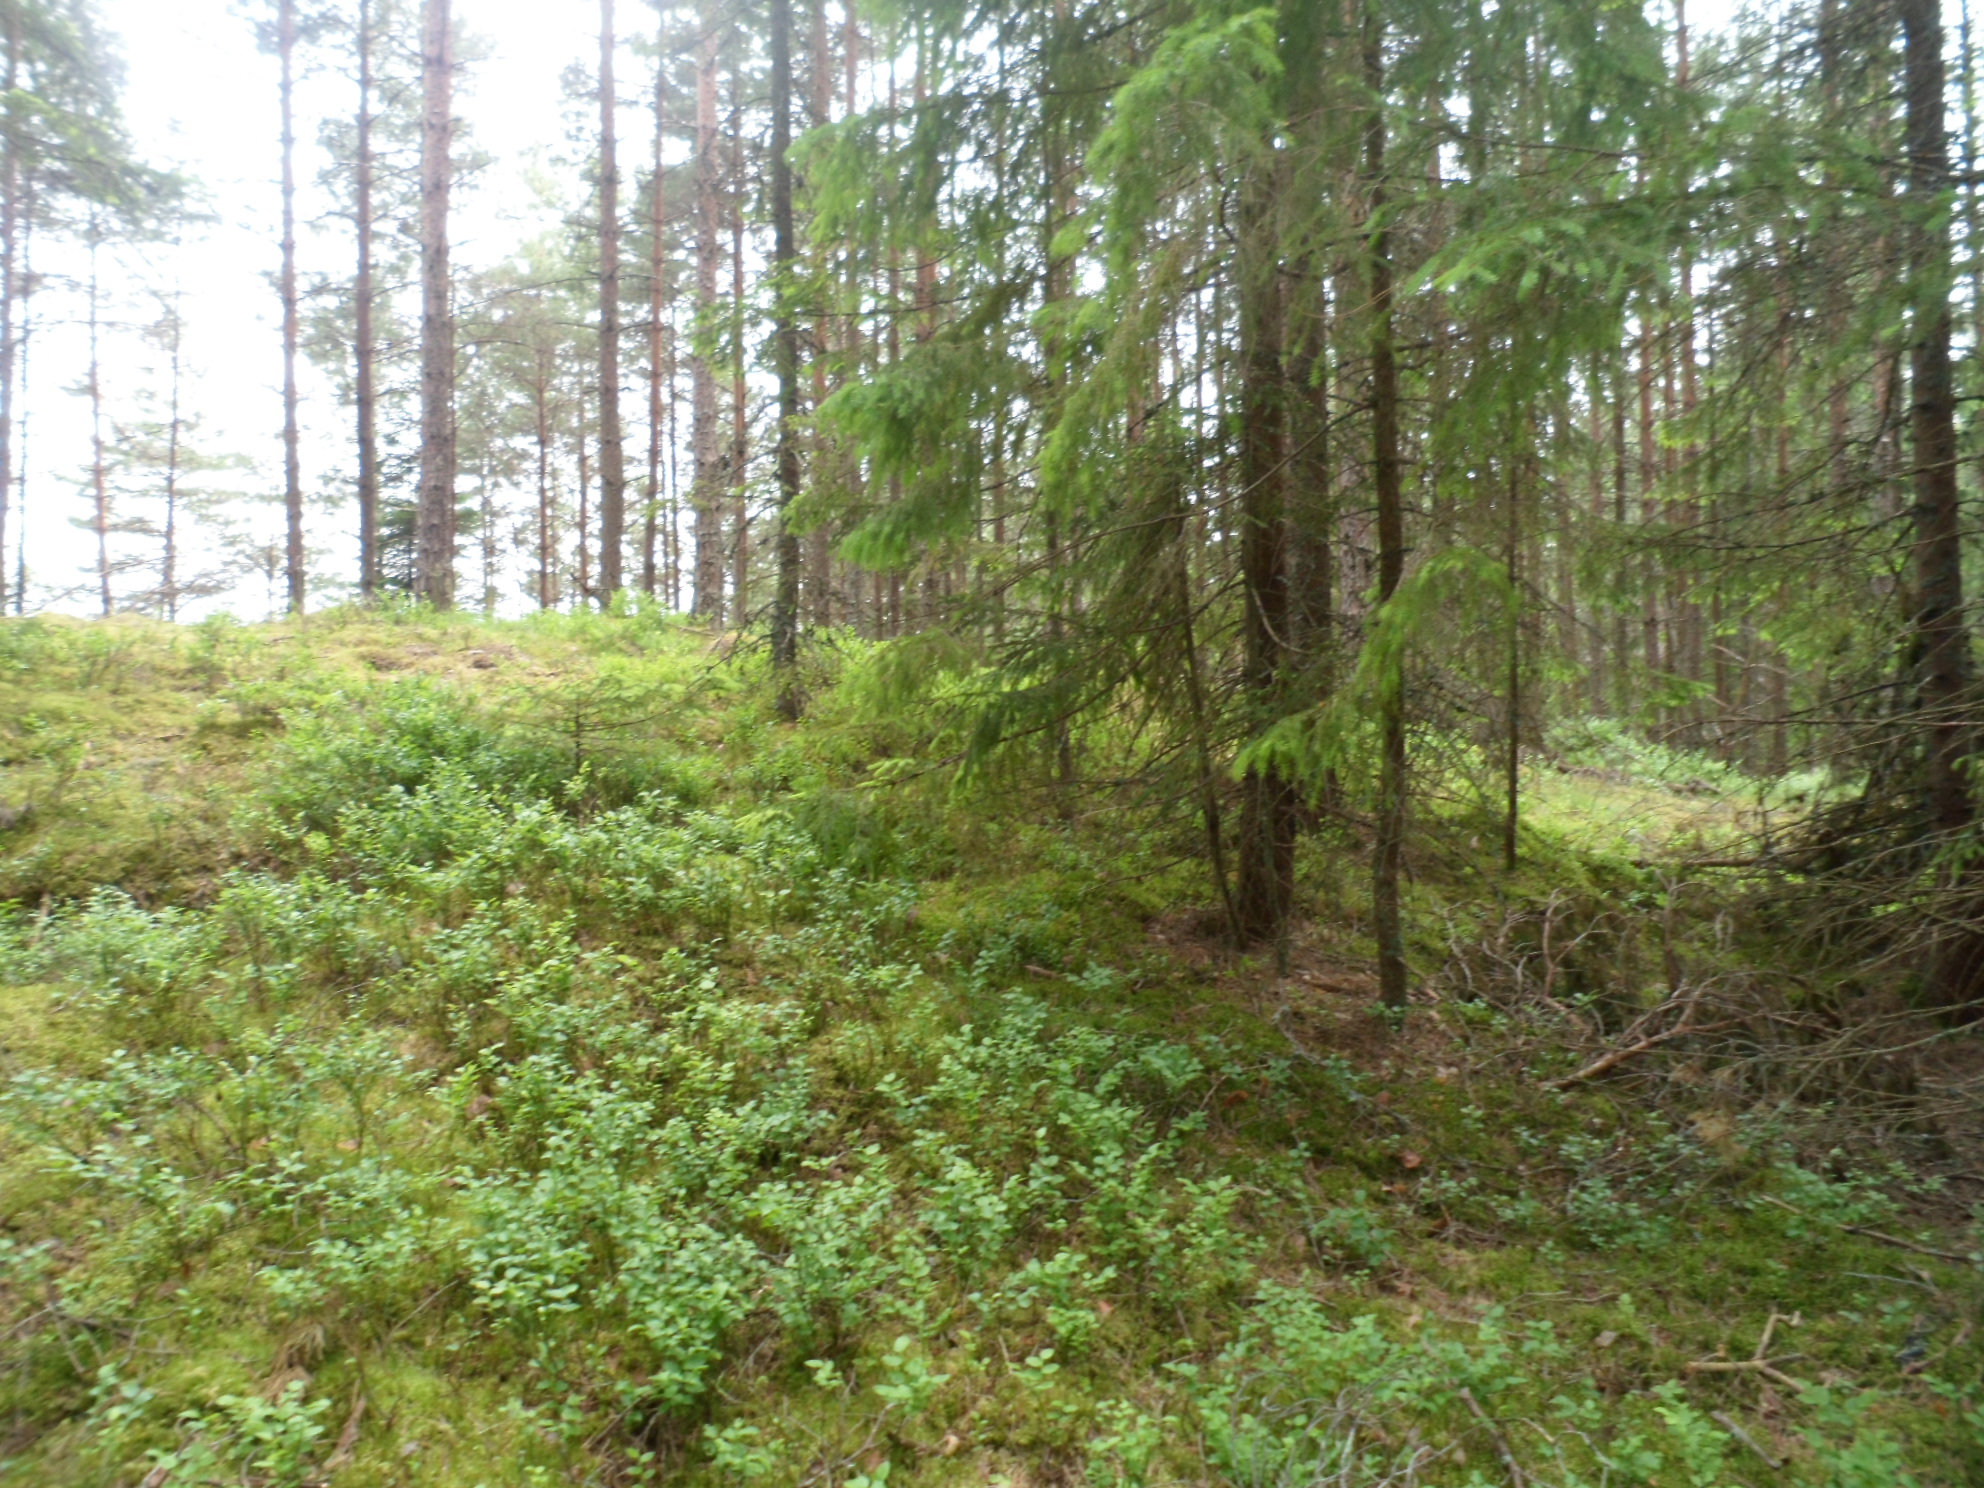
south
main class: Woodland
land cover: Pine dominated coniferous woodland
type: boreal forest
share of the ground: 50 - 75 %
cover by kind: coniferous forest trees 60 %, shrubs 20 %, lichens and mosses 20 %
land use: Forestry
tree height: > 5 m
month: June
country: SE
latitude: 56.9404
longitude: 15.3725
